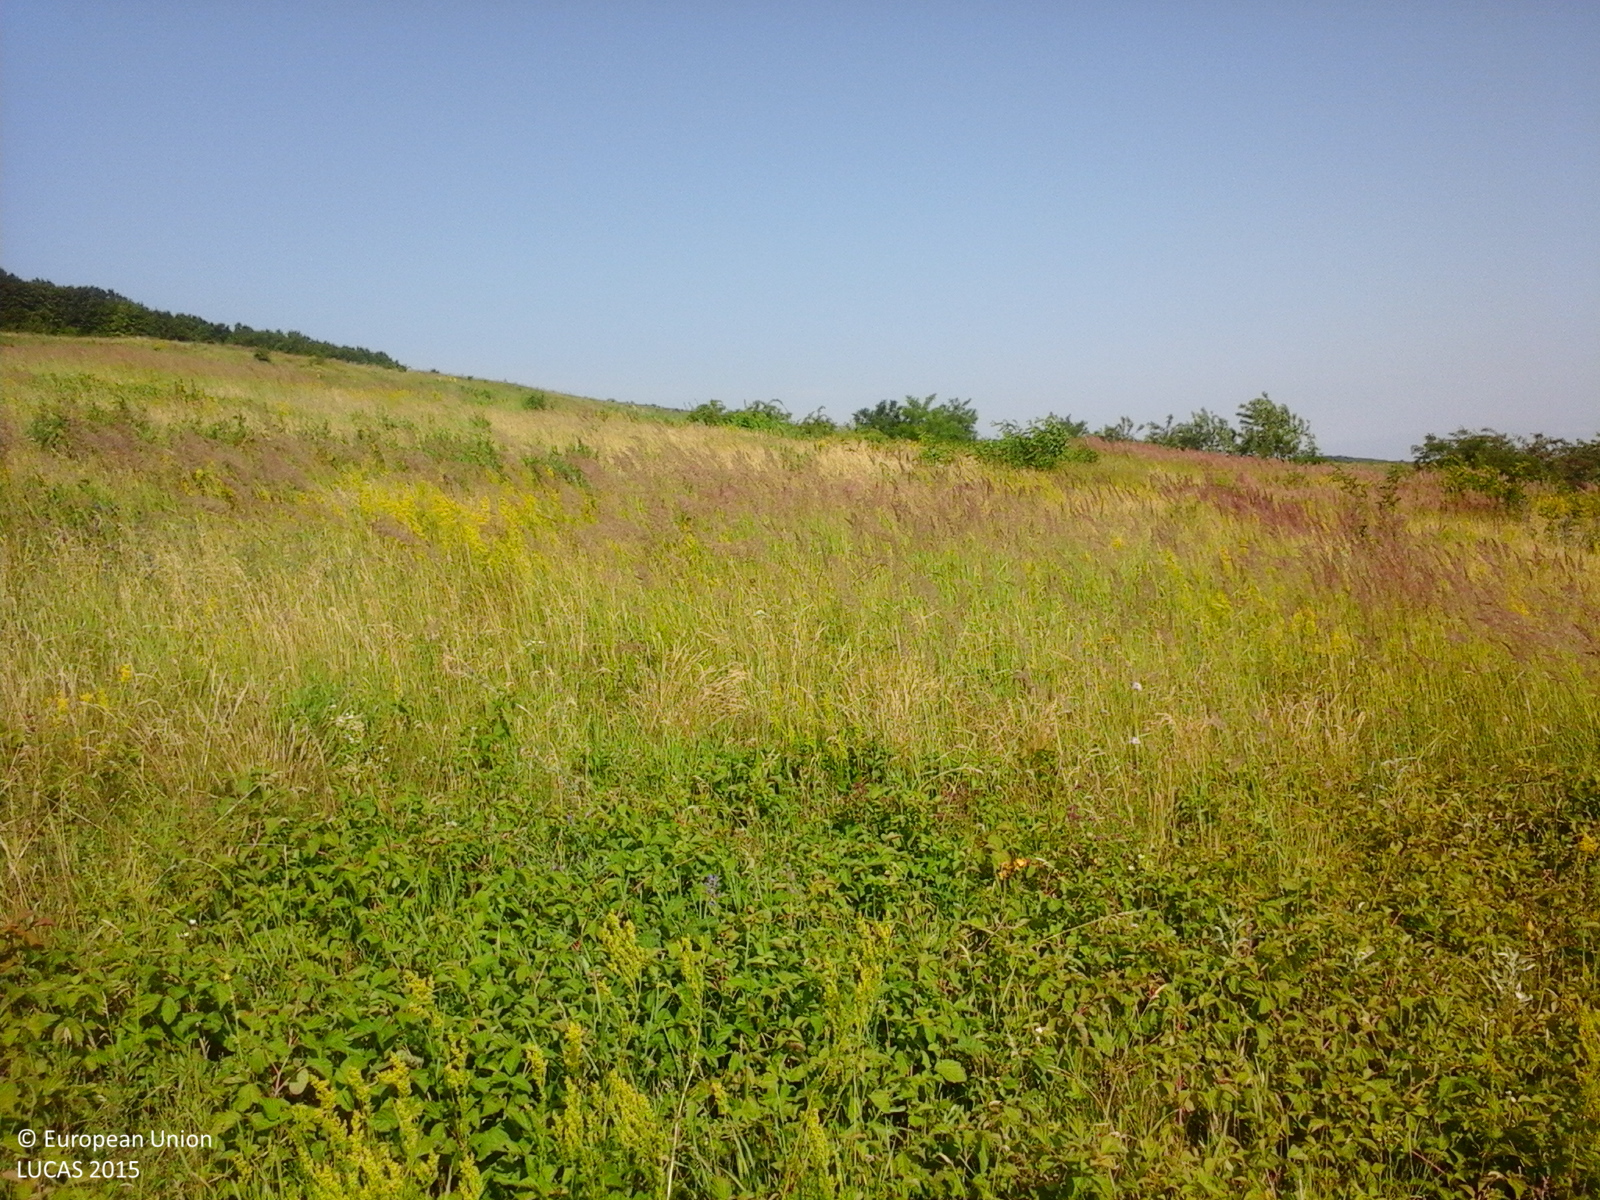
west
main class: Grassland
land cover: Grassland with sparse tree/shrub cover
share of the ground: > 75 %
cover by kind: herbaceous plants 85 %, shrubs 10 %, broadleaved forest trees 5 %
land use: Fallow land
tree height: < 5 m
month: June
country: RO
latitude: 46.6425
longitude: 27.3927
